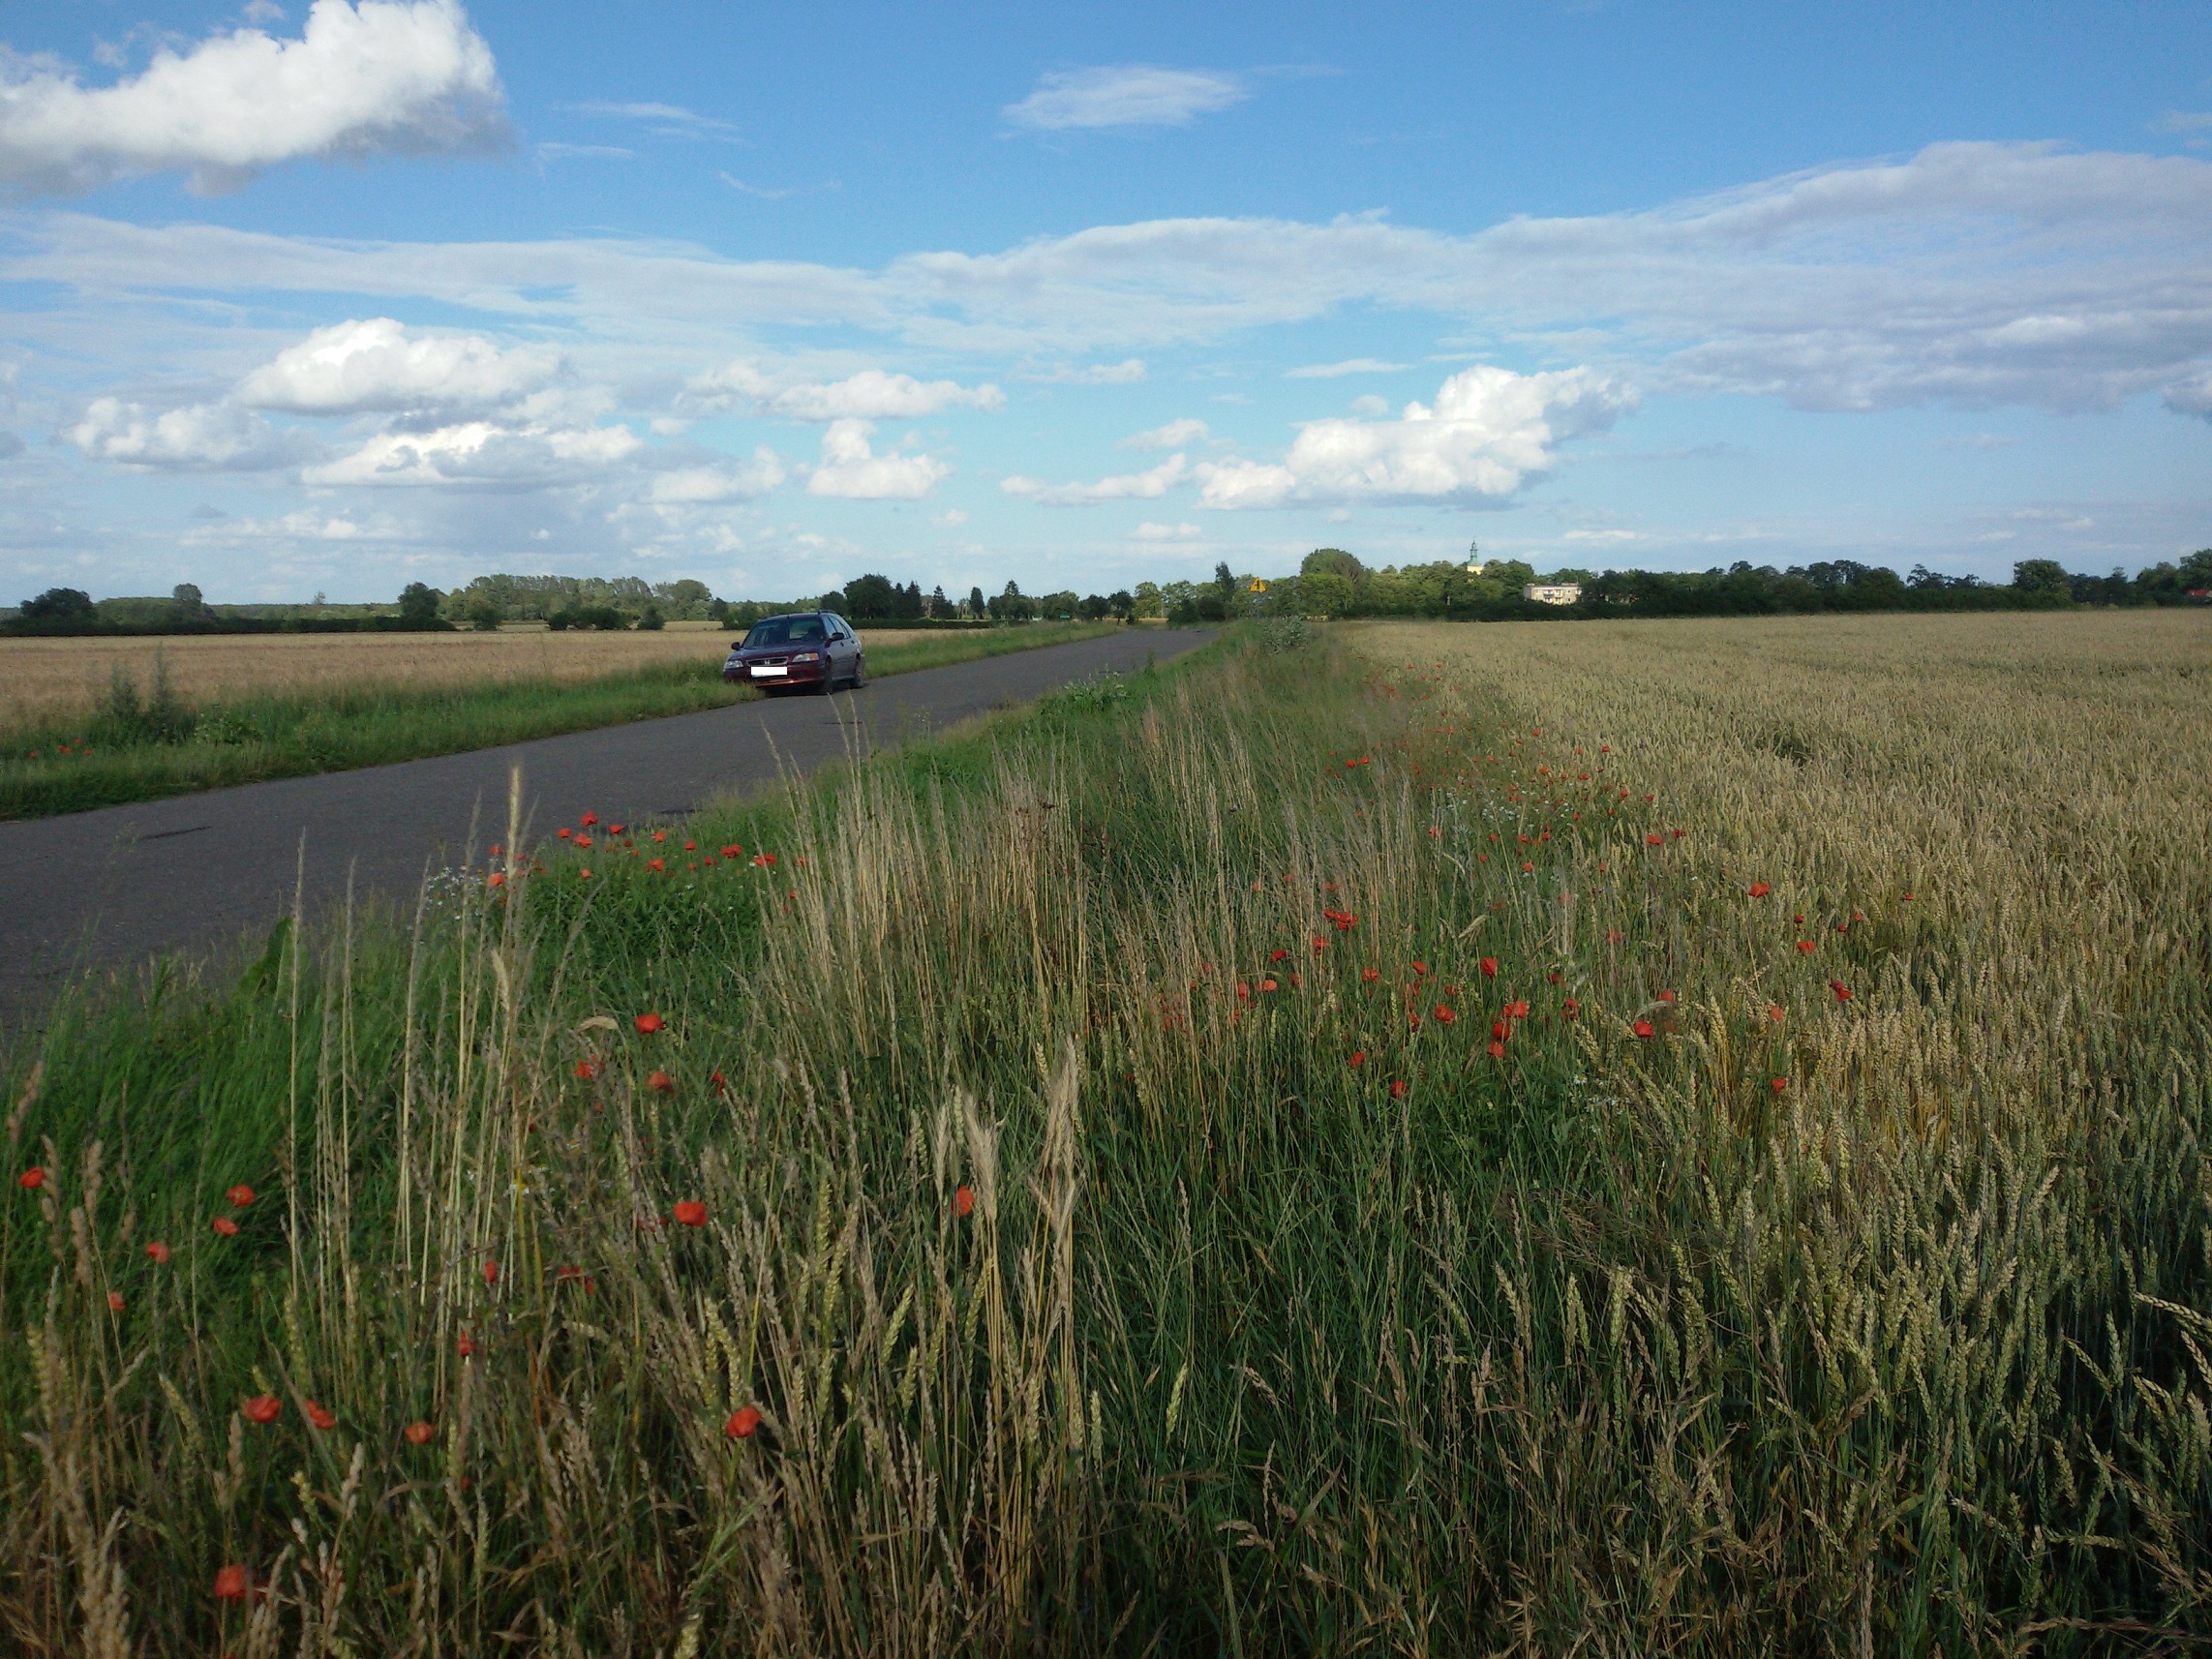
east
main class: Cropland
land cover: Rape and turnip rape
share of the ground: > 75 %
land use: Agriculture (excluding fallow land and kitchen gardens)
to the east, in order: Rape and turnip rape; Common wheat; Grass margins; Common wheat
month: July
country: PL
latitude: 52.6613
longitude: 17.5382
